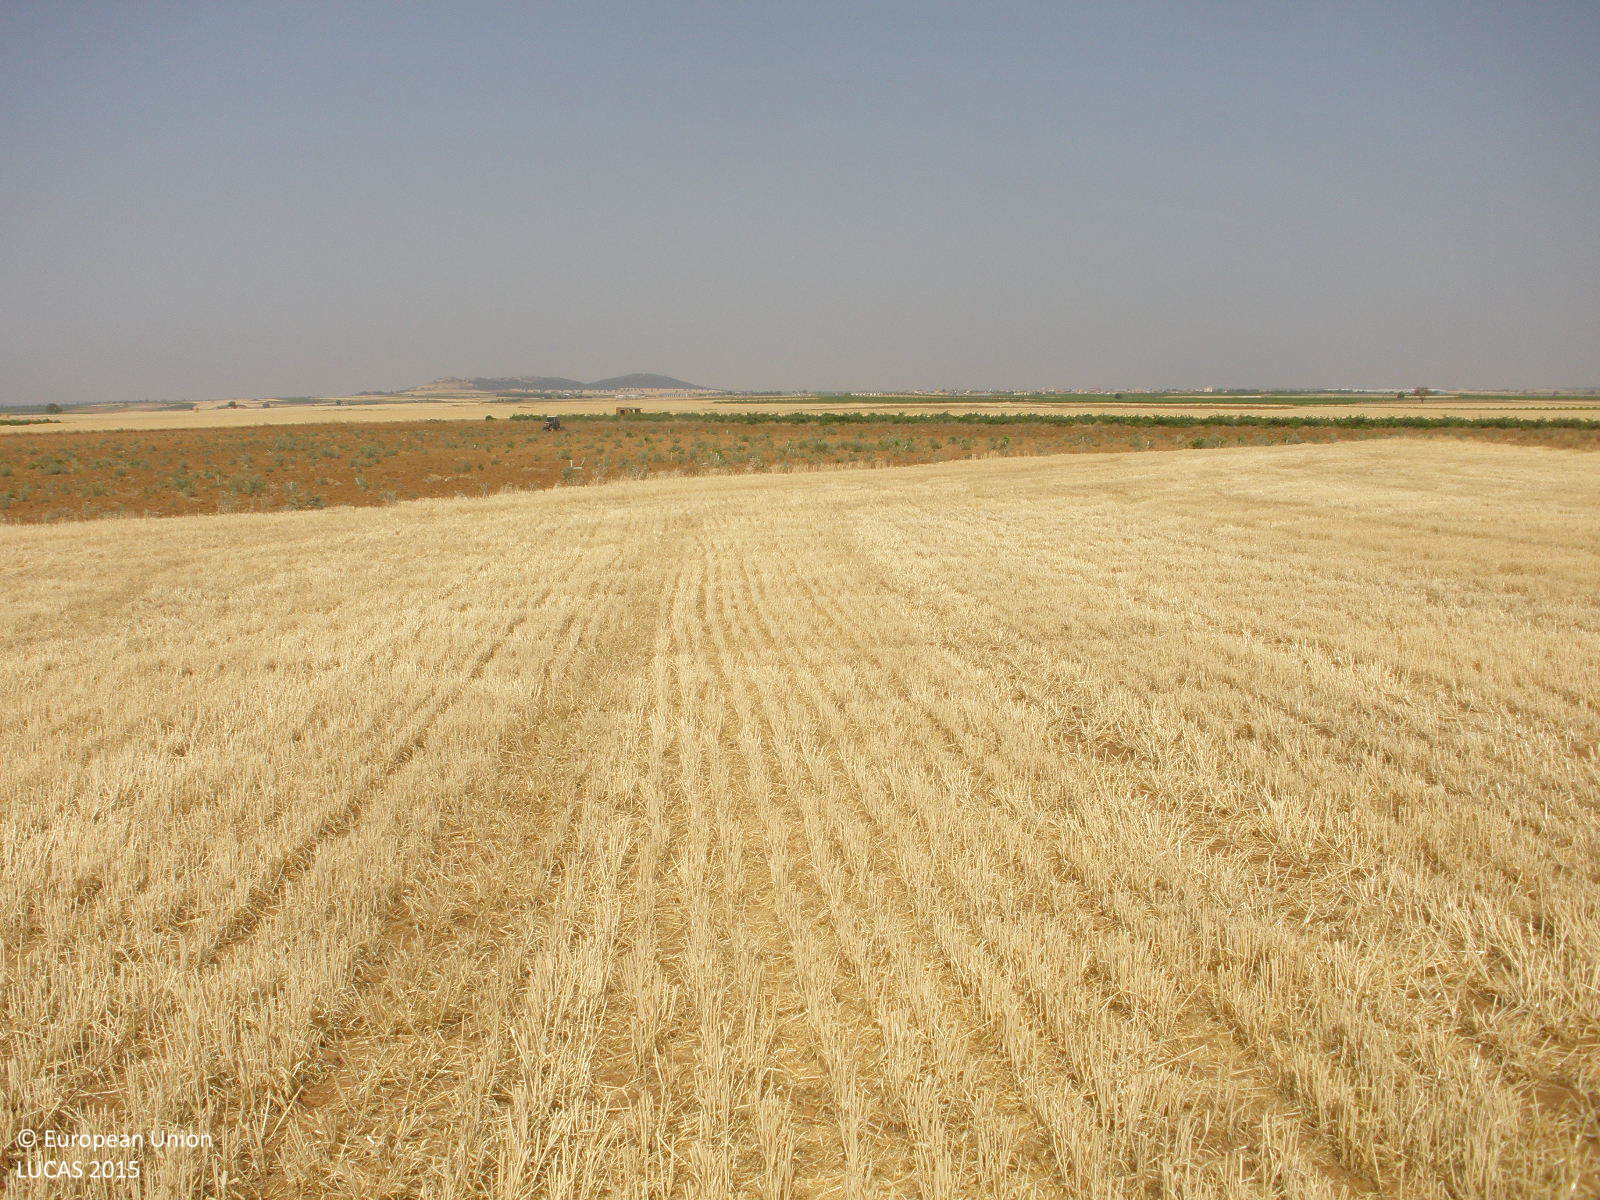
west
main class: Cropland
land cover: Barley
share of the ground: < 10 %
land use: Agriculture (excluding fallow land and kitchen gardens)
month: July
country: ES
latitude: 39.7503
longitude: -3.1046
